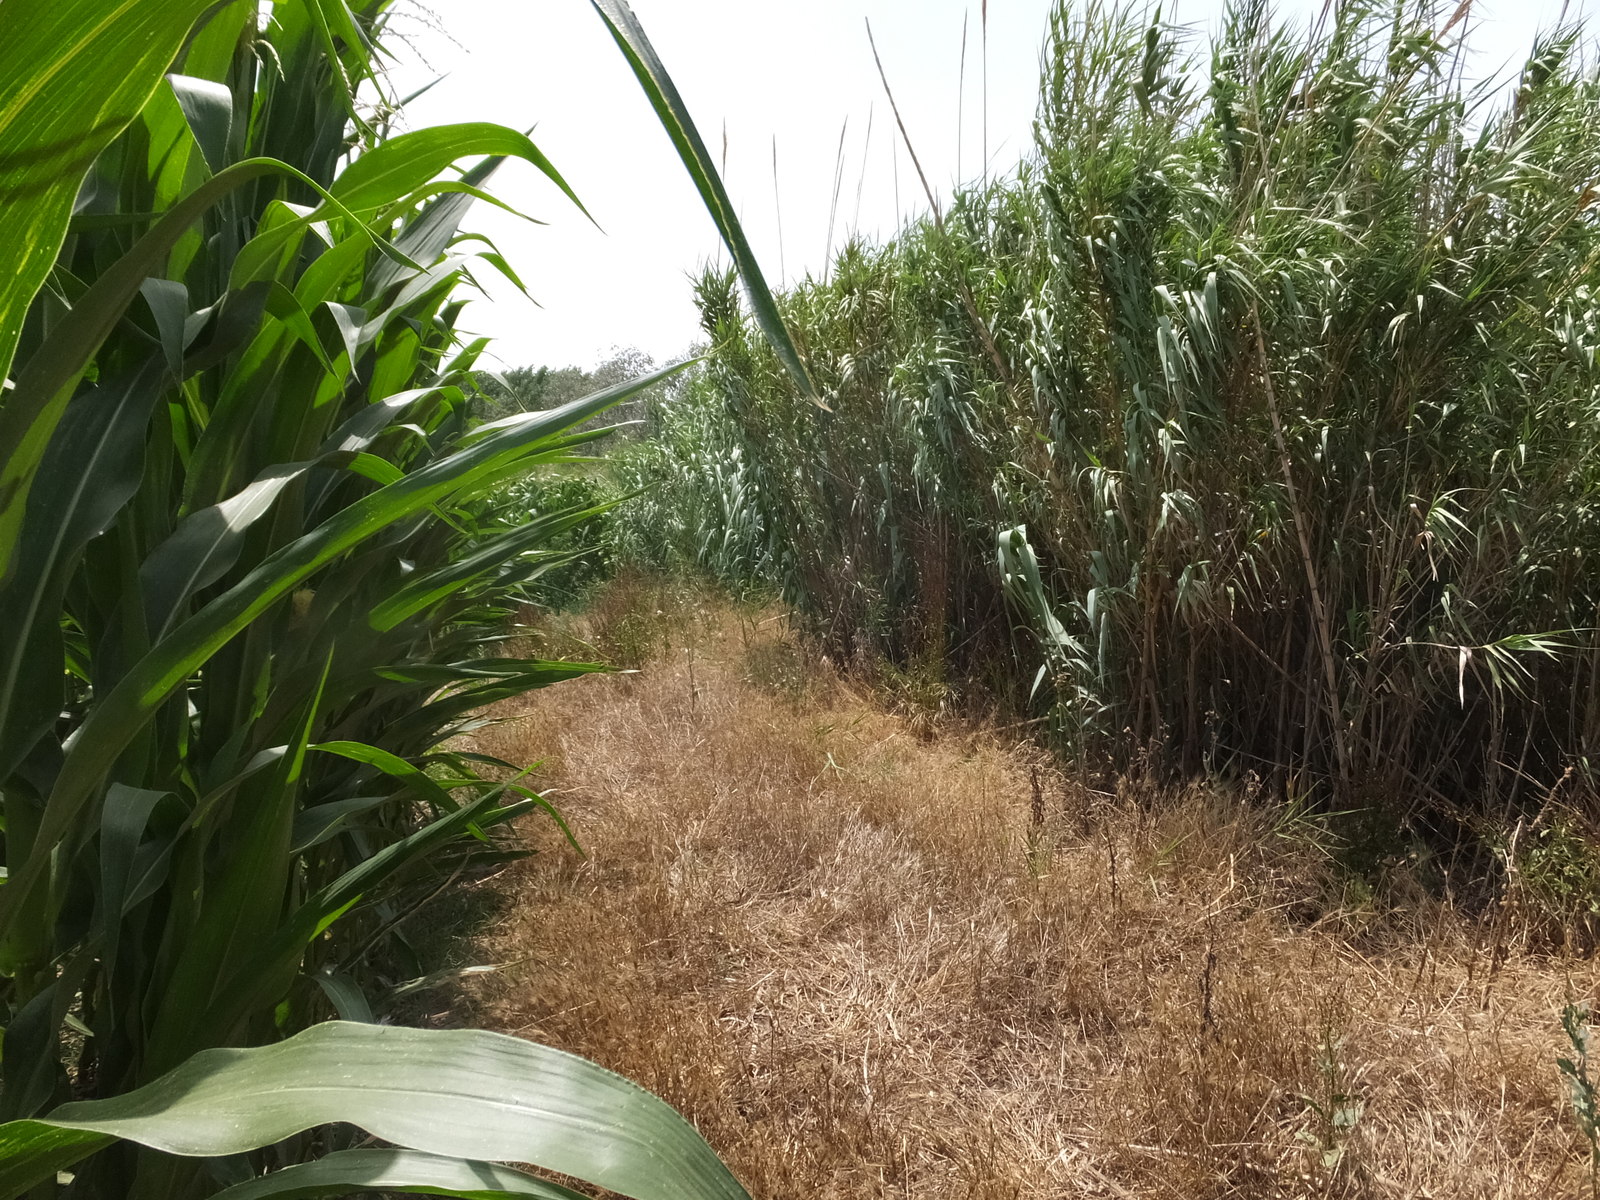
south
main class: Cropland
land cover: Maize
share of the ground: > 75 %
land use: Agriculture (excluding fallow land and kitchen gardens)
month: July
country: ES
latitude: 41.7351
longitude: 0.1374
